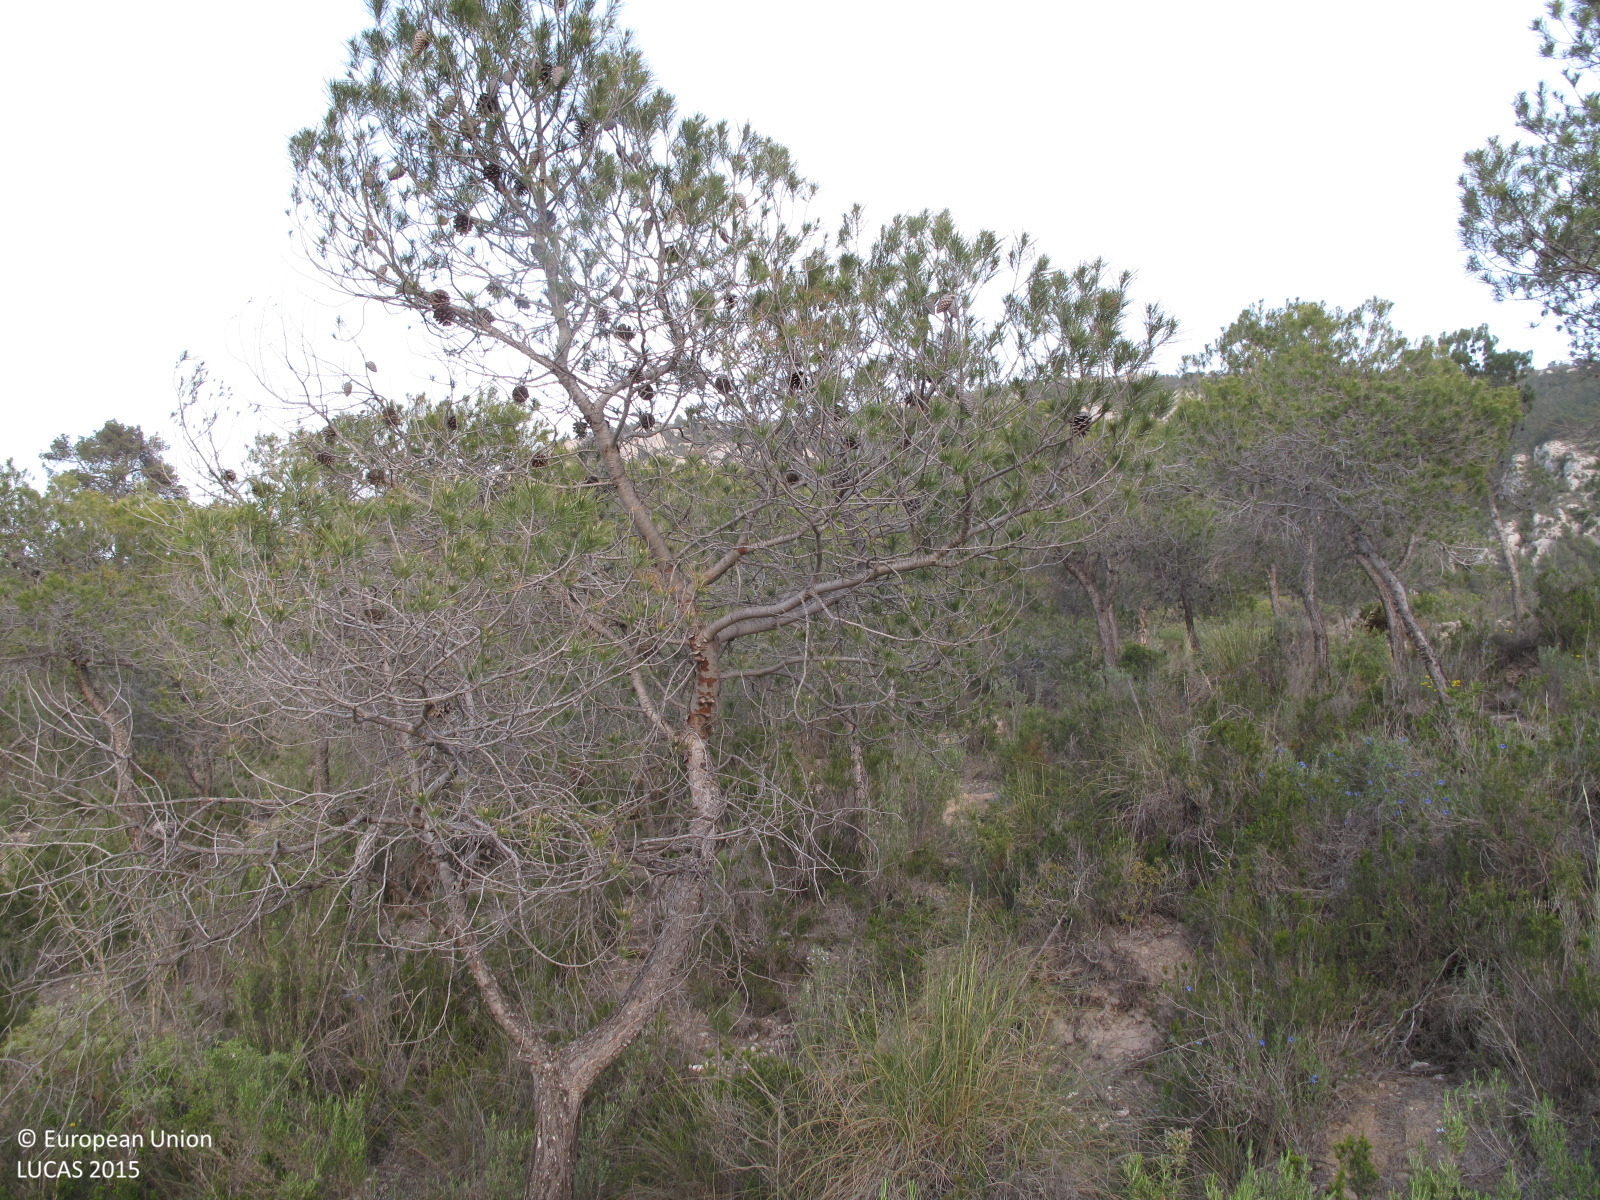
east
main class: Woodland
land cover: Pine dominated coniferous woodland
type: coniferous forest of the mediterranean region
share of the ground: 50 - 75 %
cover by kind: coniferous forest trees 50 %, shrubs 20 %, consolidated bare surface 20 %, herbaceous plants 10 %
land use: Semi-natural and natural areas not in use
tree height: > 5 m
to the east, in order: Pine dominated coniferous woodland
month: April
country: ES
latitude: 38.6112
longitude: -0.7962
